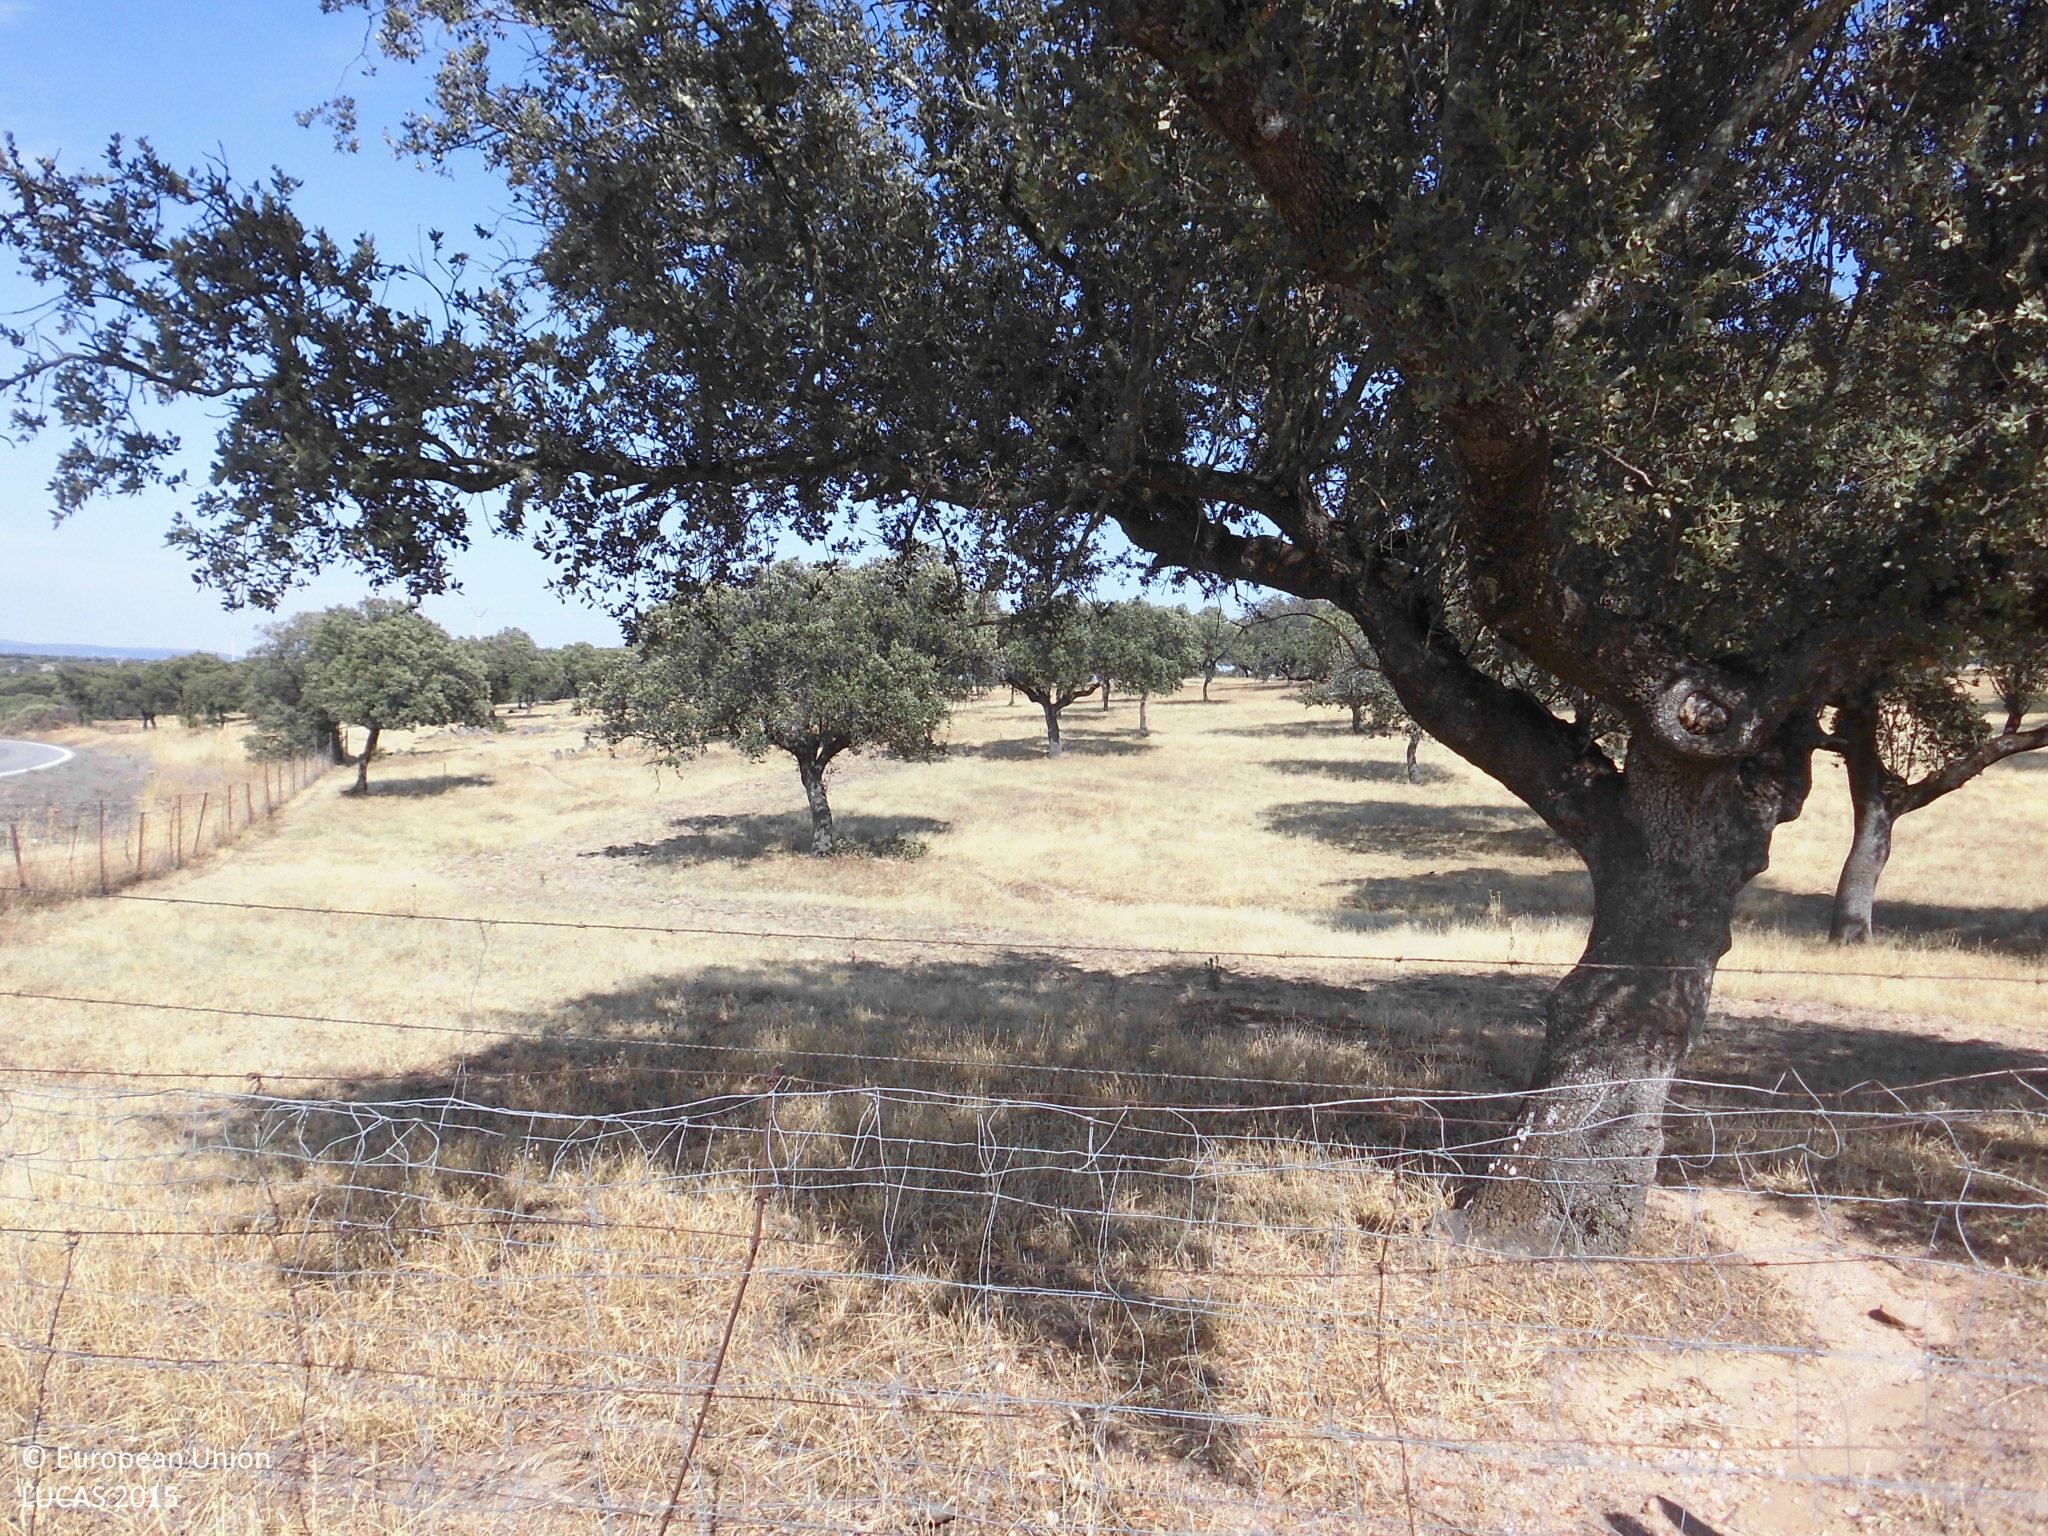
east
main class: Woodland
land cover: Broadleaved woodland
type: broadleaved evergreen forest
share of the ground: 25 - 50 %
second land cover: Grassland without tree/shrub cover
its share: > 75 %
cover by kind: herbaceous plants 70 %, broadleaved forest trees 30 %
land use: Forestry
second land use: Agriculture (excluding fallow land and kitchen gardens)
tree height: > 5 m
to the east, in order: Broadleaved woodland; Grassland without tree/shrub cover; Broadleaved woodland; Tracks; Broadleaved woodland
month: June
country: ES
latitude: 39.7434
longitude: -6.0656
